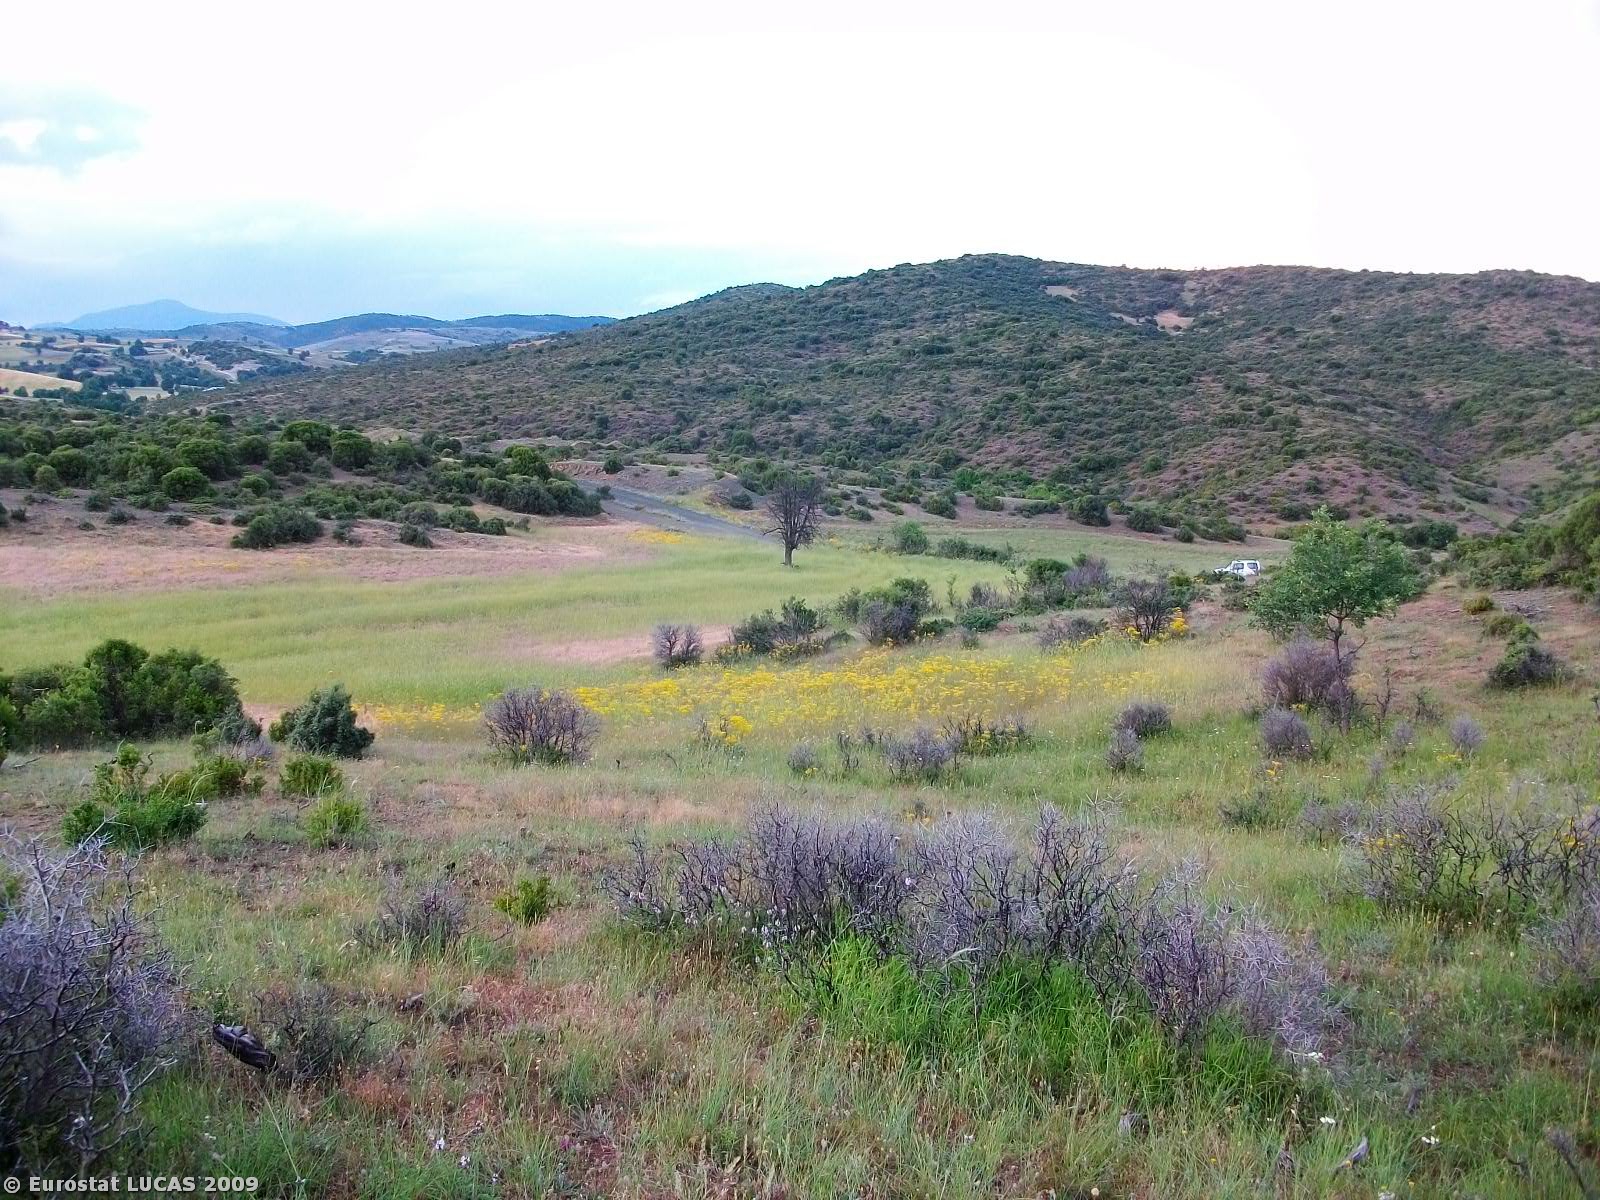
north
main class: Shrubland
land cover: Shrubland without tree cover
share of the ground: 25 - 50 %
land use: Agriculture (excluding fallow land and kitchen gardens)
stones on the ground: 25 - 50 %
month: June
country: GR
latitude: 40.0221
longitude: 21.6934
